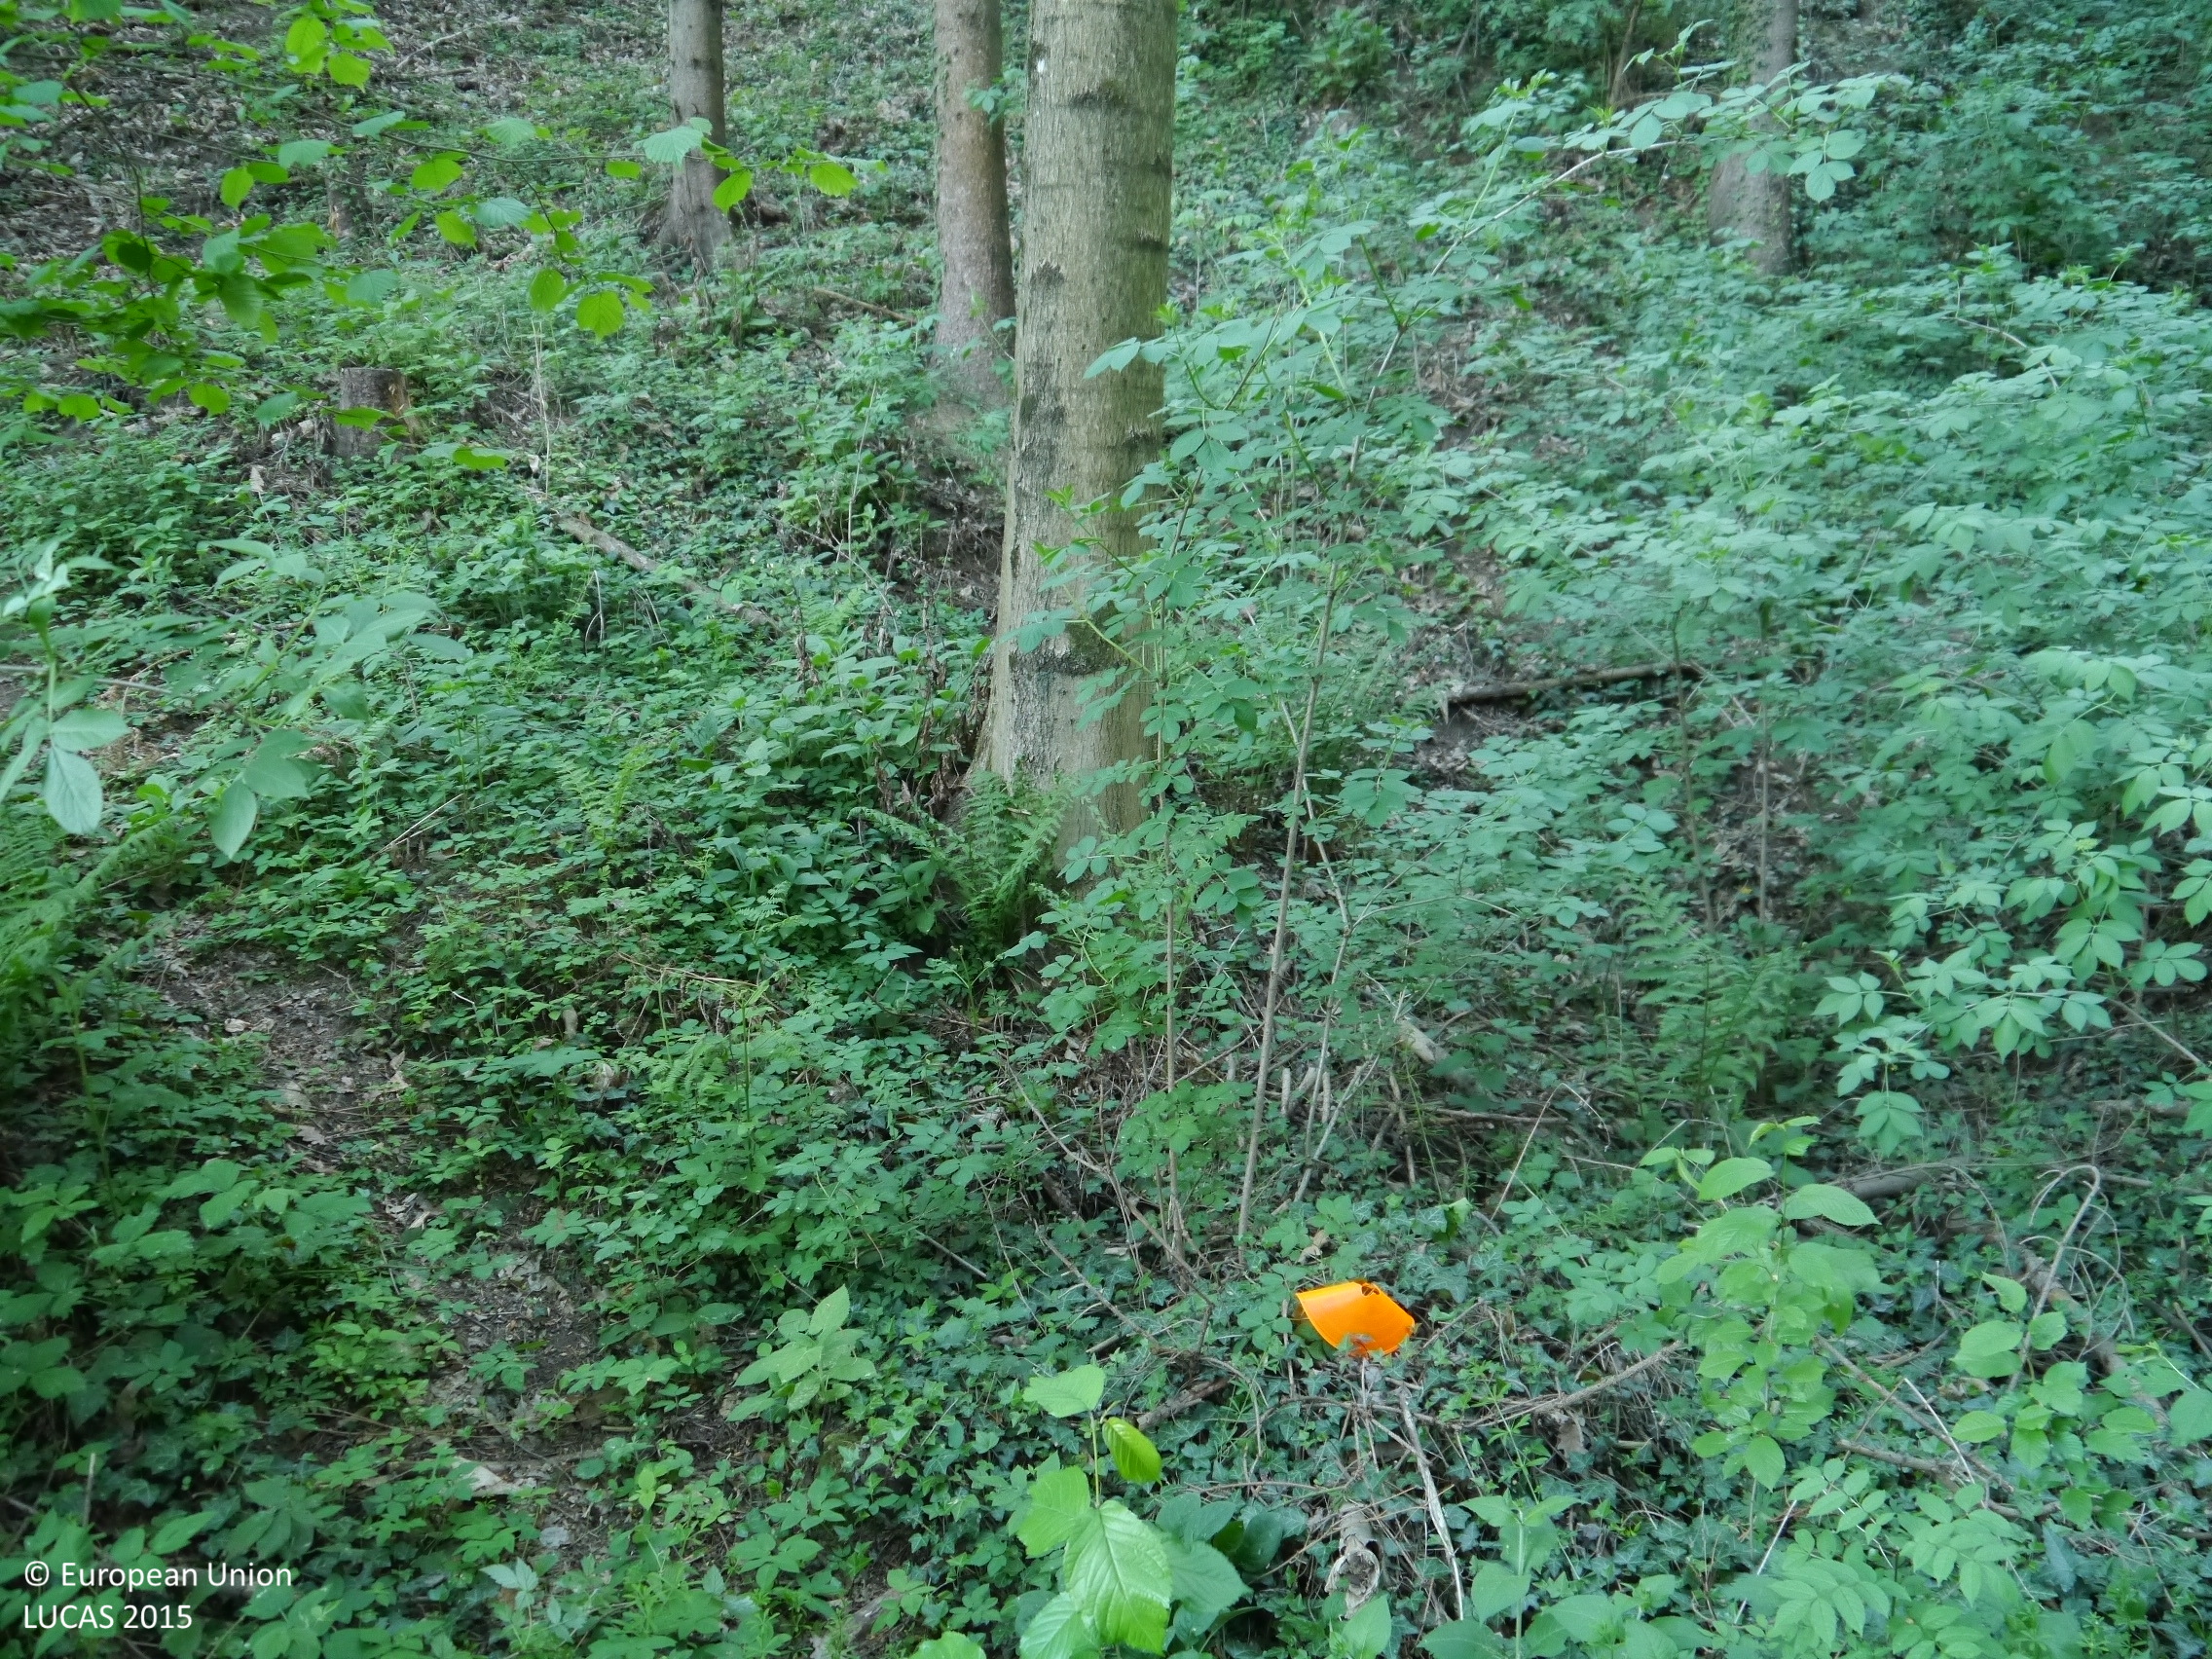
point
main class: Woodland
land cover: Spruce dominated coniferous woodland
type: hemiboreal forest and nemoral coniferous forest and mixed broadleaved-coniferous forest
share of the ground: > 75 %
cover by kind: coniferous forest trees 75 %, broadleaved forest trees 20 %, herbaceous plants 5 %
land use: Forestry
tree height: > 5 m
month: May
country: AT
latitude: 47.0843
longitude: 15.3343
